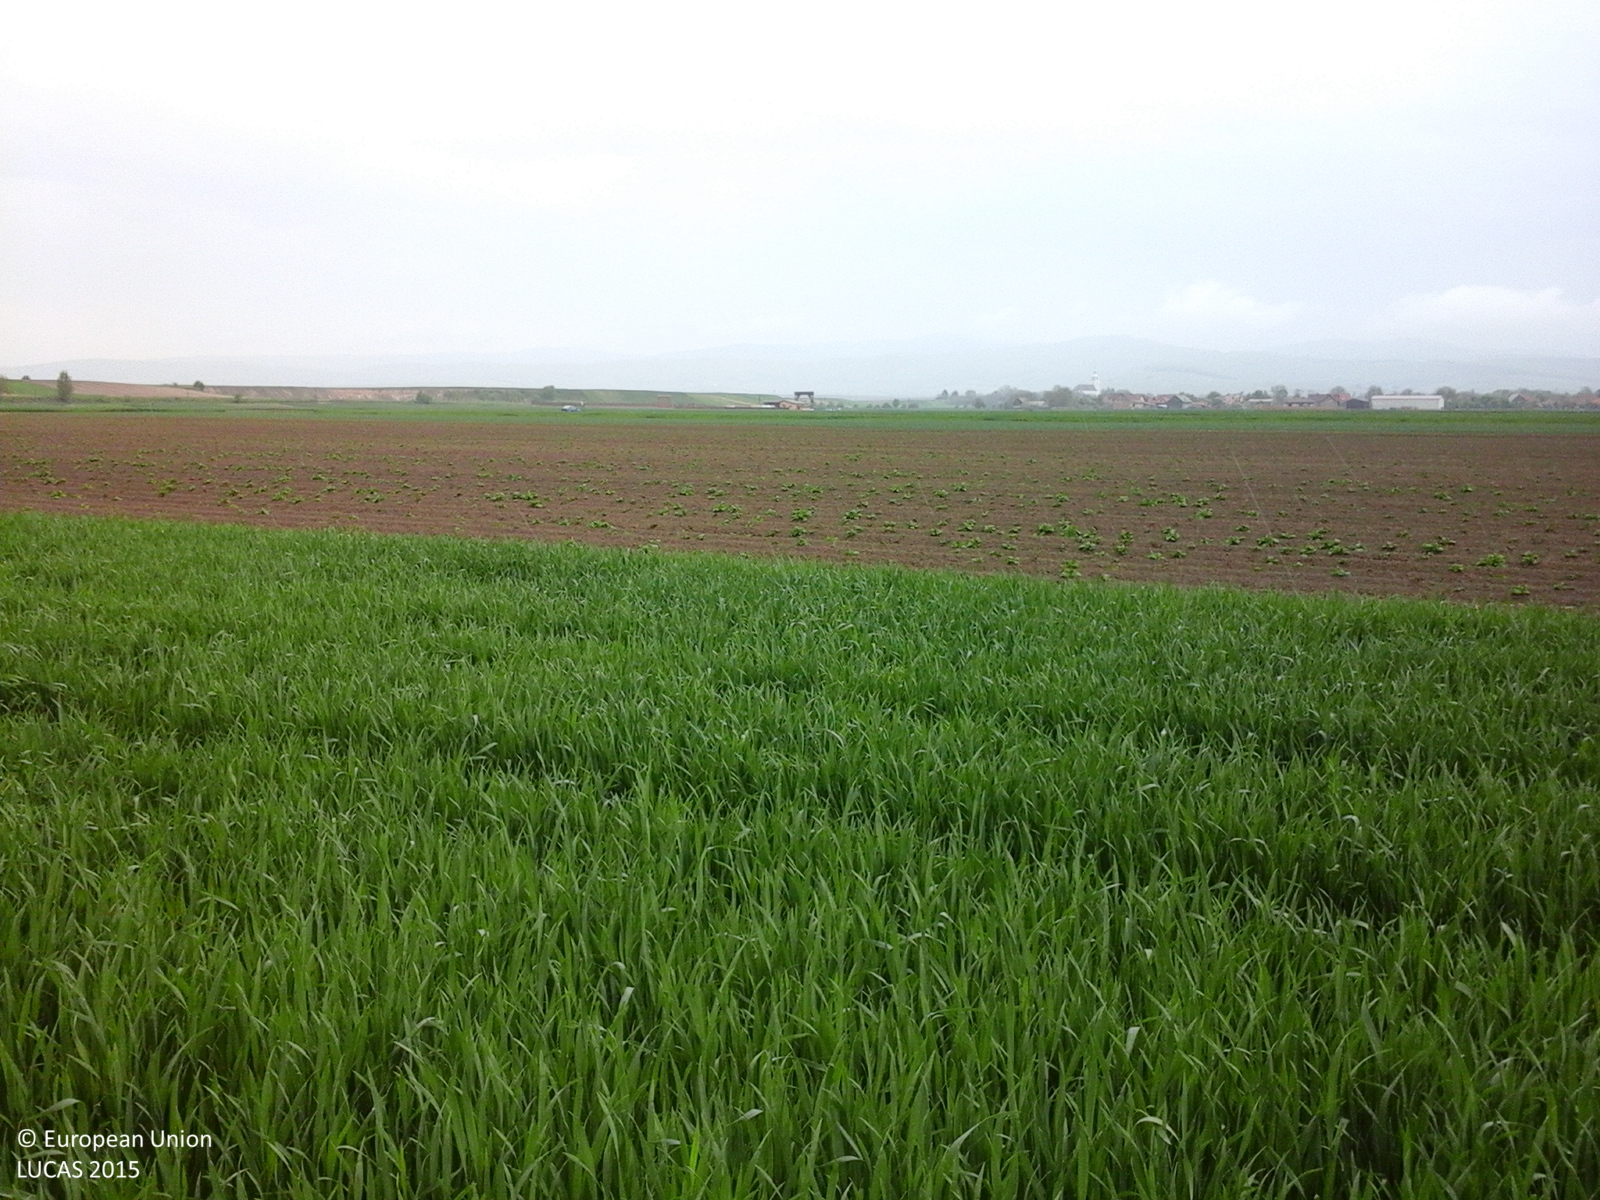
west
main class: Cropland
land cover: Common wheat
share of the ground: > 75 %
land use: Fallow land
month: May
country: RO
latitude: 46.0209
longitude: 26.0984
